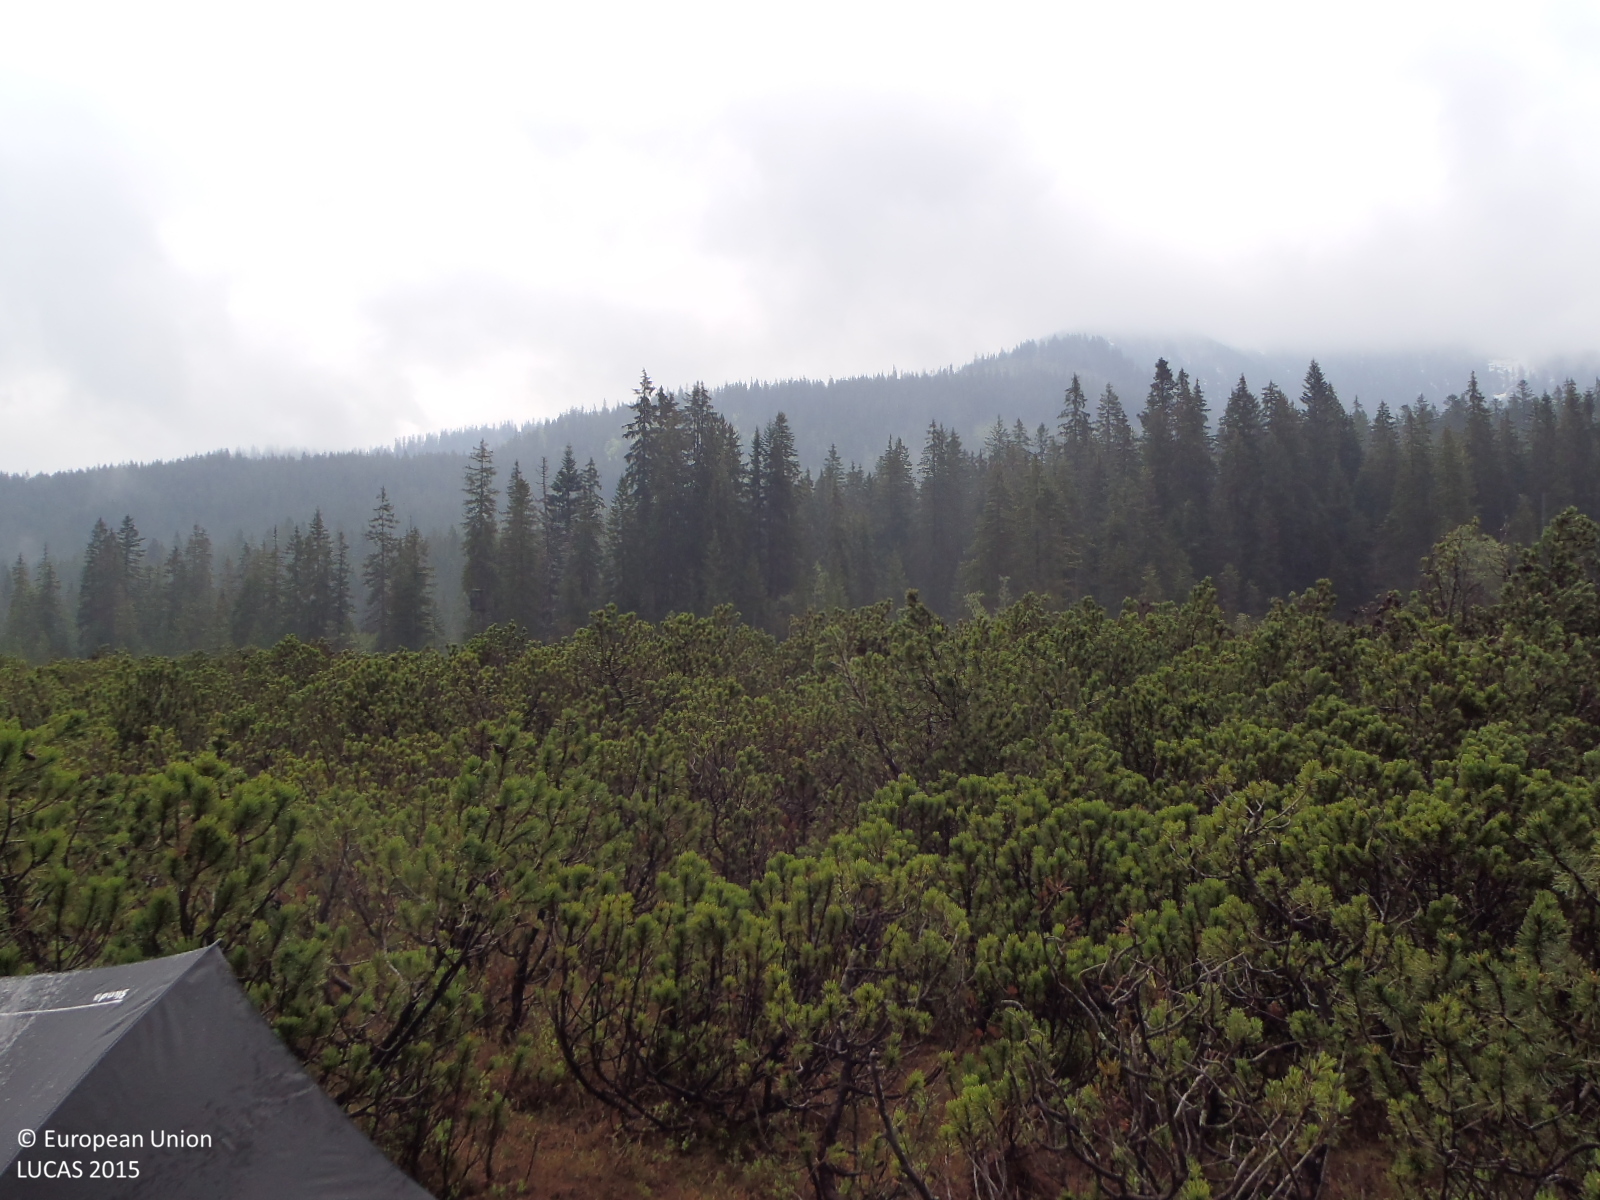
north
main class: Woodland
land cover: Pine dominated coniferous woodland
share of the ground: > 75 %
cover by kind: coniferous forest trees 80 %, herbaceous plants 10 %, shrubs 5 %, lichens and mosses 5 %
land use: Forestry
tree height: < 5 m
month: May
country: AT
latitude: 47.6528
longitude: 12.5946
